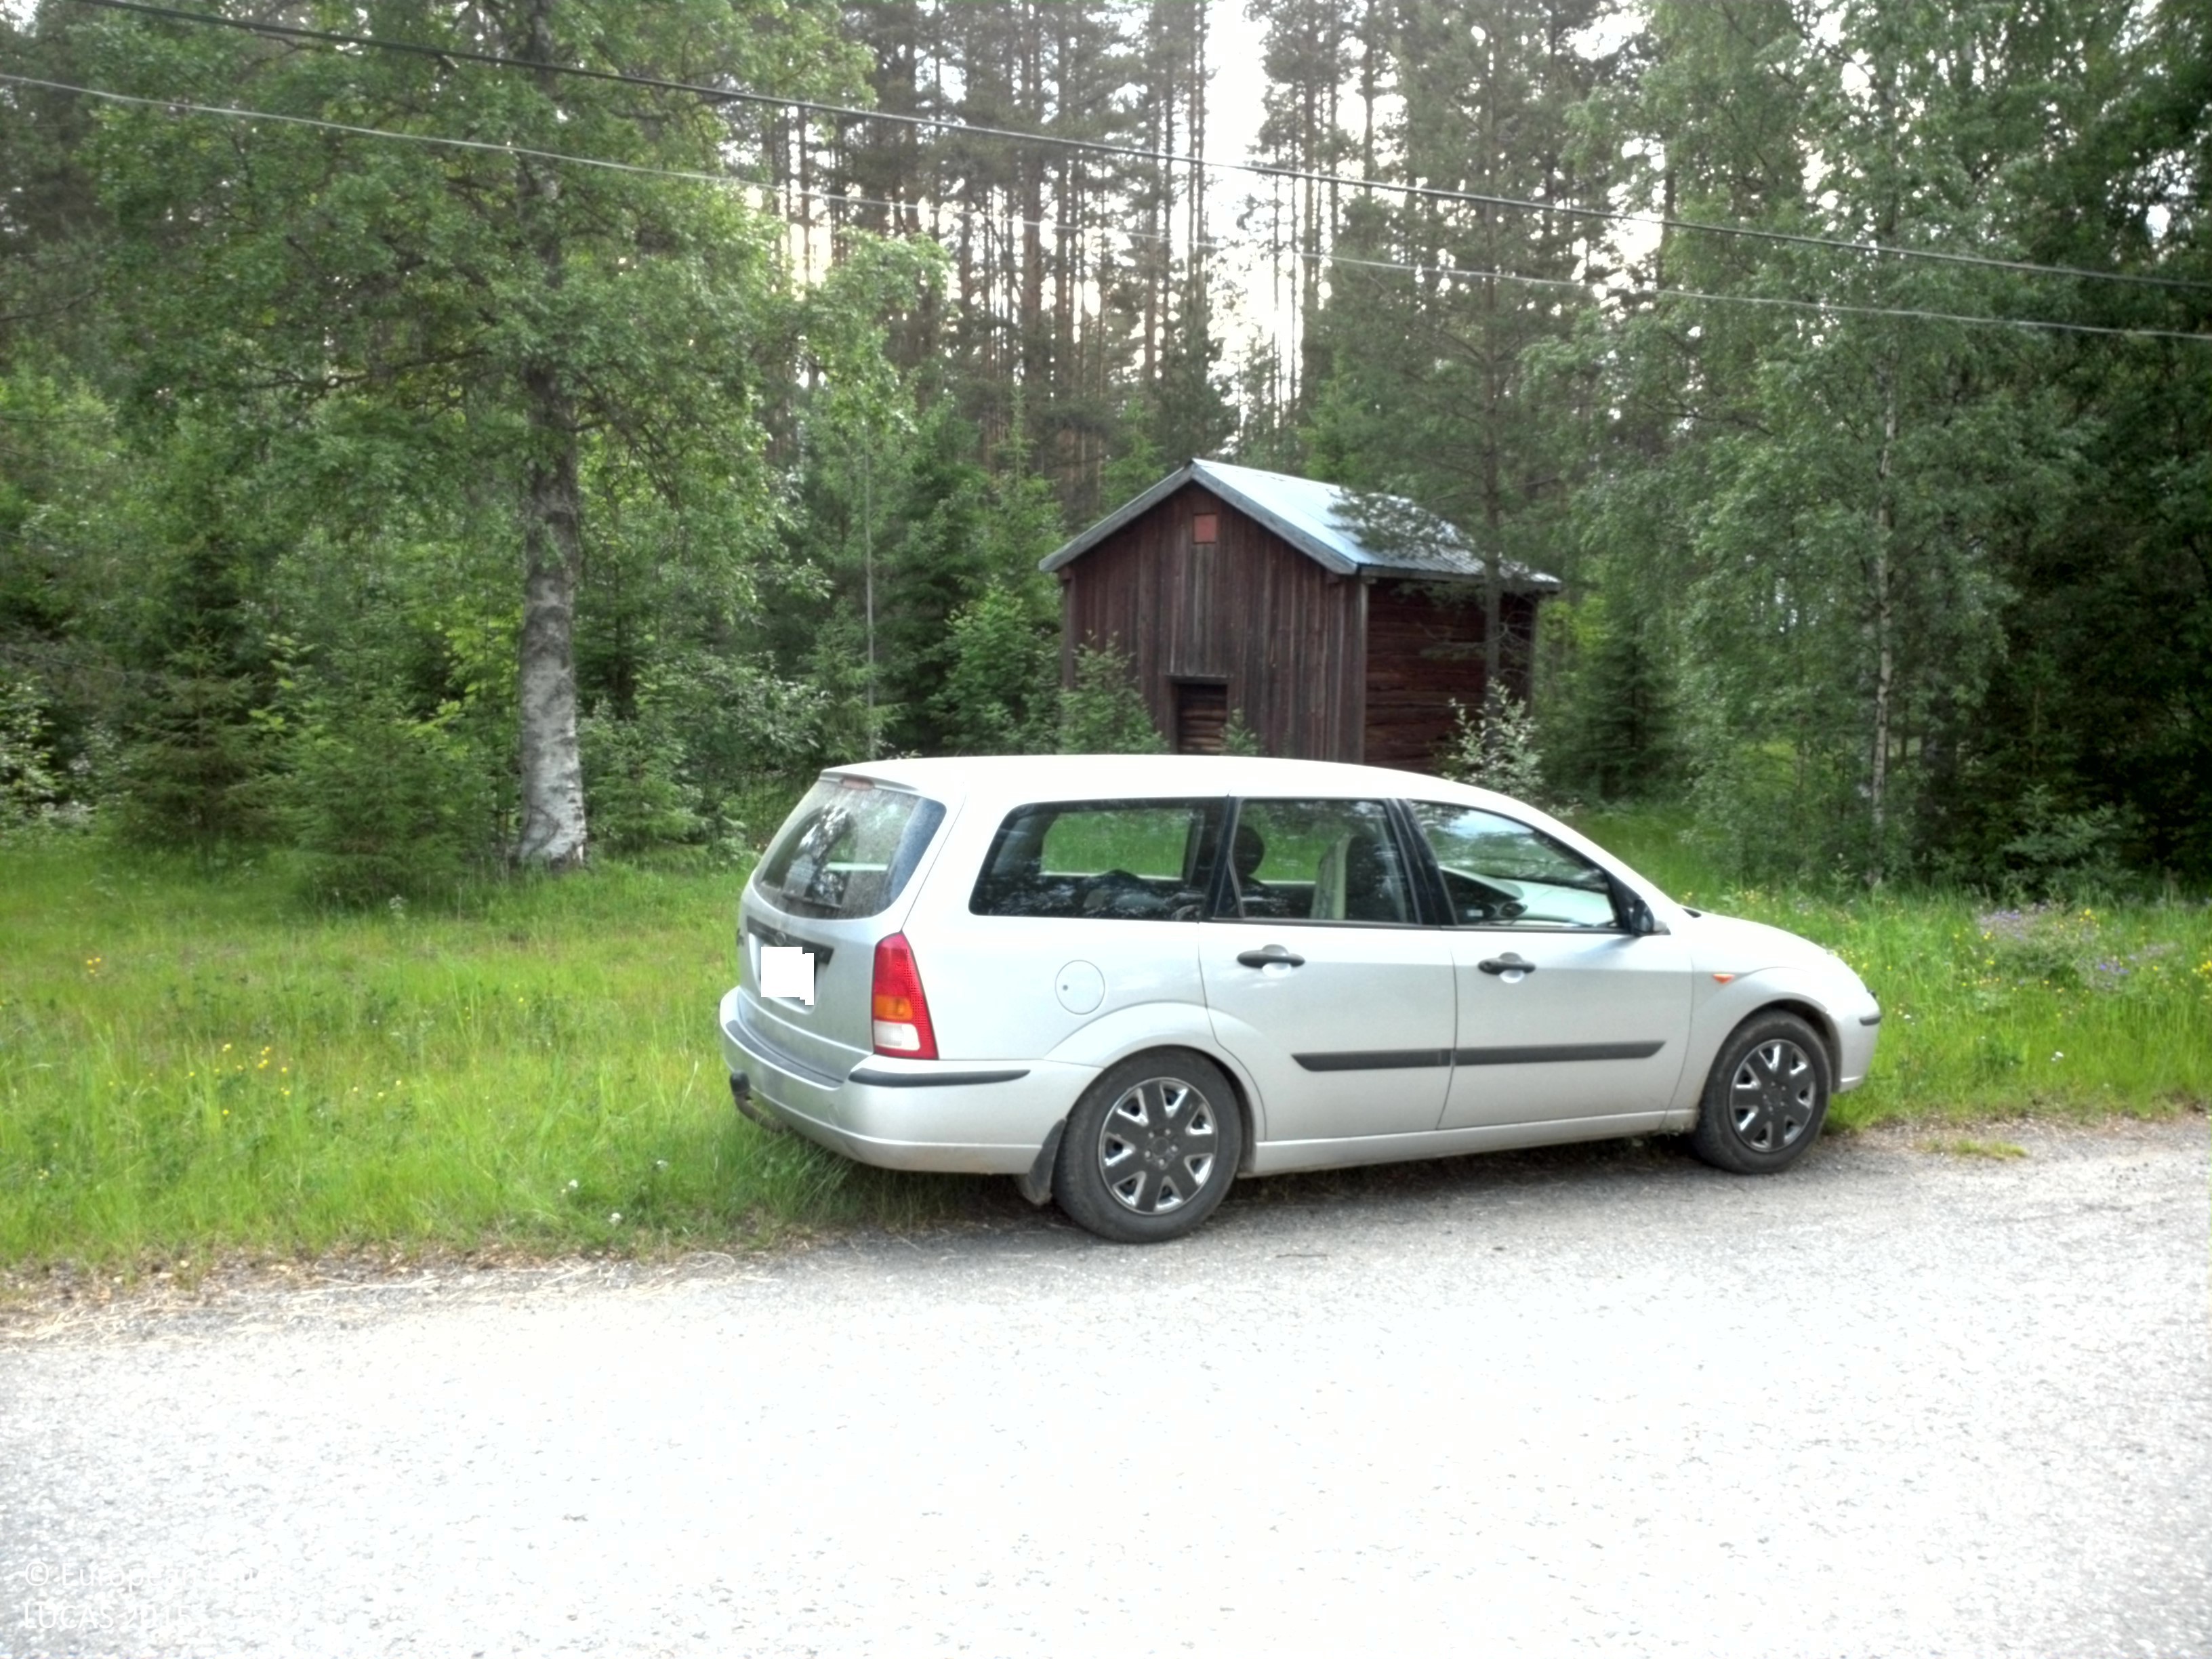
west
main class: Grassland
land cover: Grassland with sparse tree/shrub cover
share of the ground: > 75 %
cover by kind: herbaceous plants 95 %, broadleaved forest trees 5 %
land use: Residential
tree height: > 5 m
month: July
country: SE
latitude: 64.4812
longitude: 20.8606
